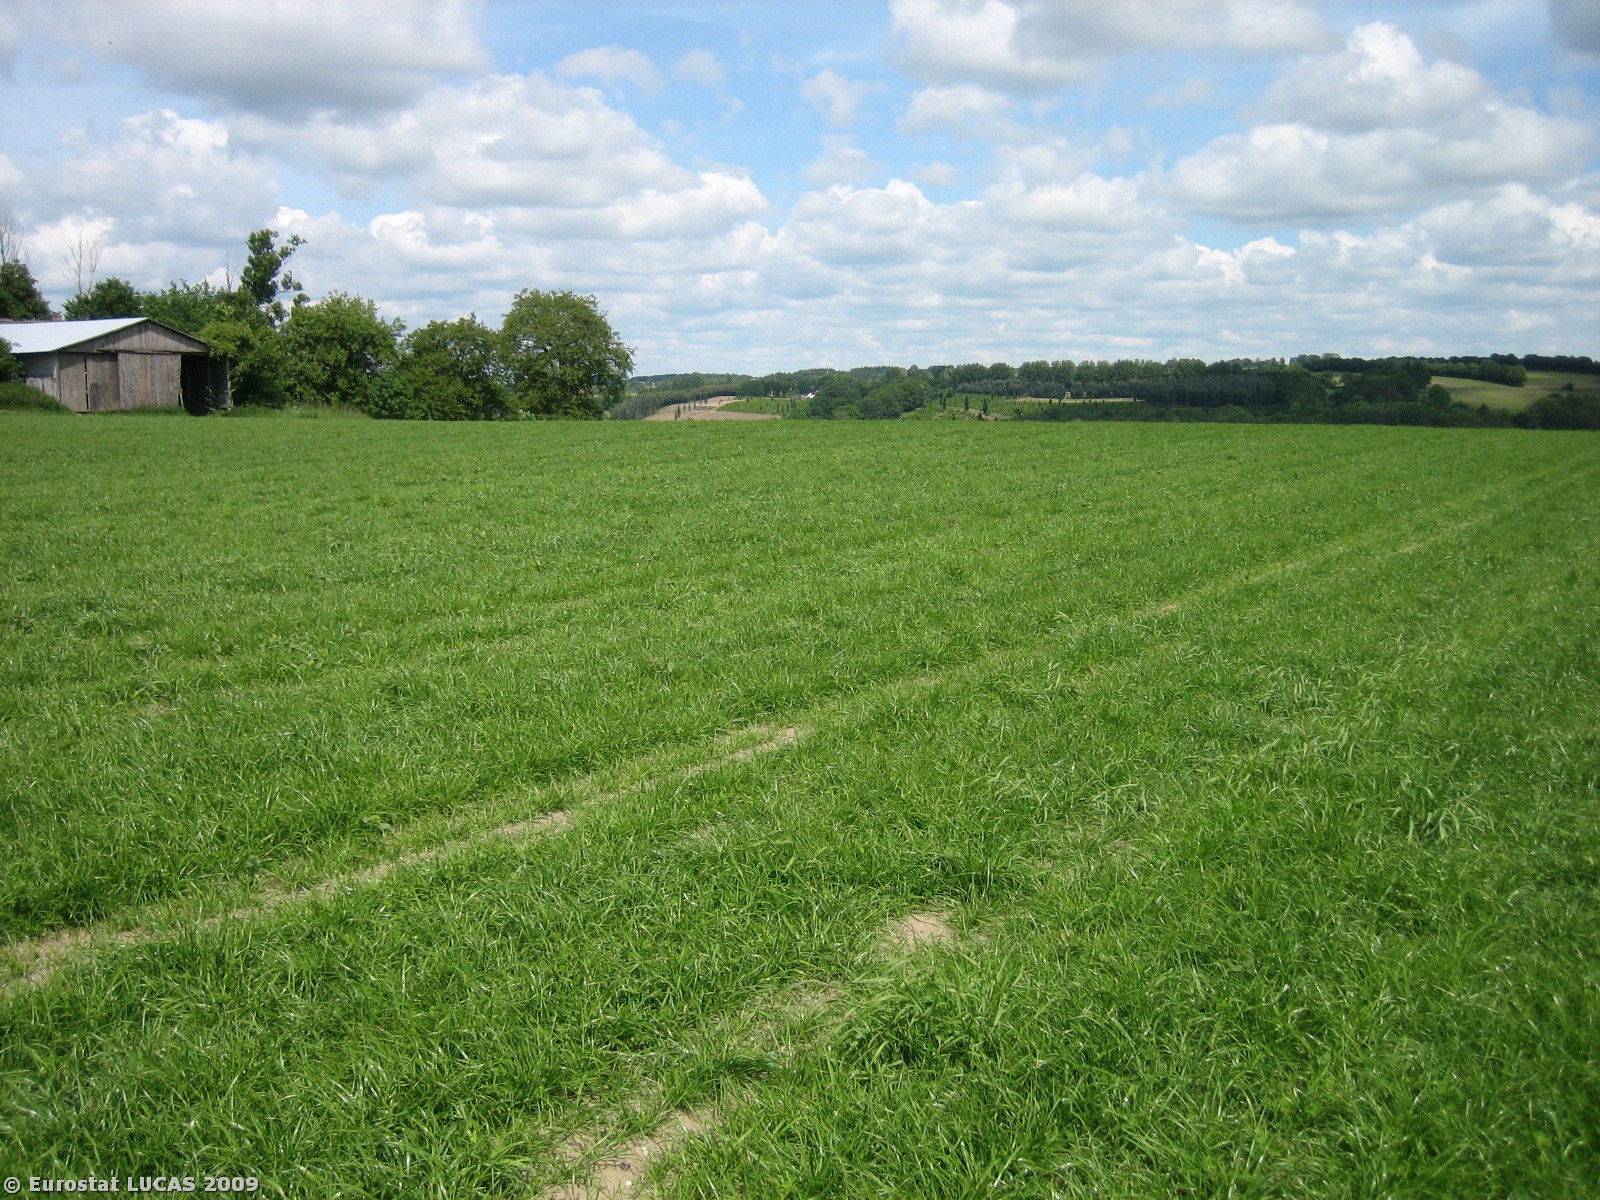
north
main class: Cropland
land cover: Temporary grasslands
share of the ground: 50 - 75 %
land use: Agriculture (excluding fallow land and kitchen gardens)
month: June
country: DK
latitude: 56.0617
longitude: 9.7915
